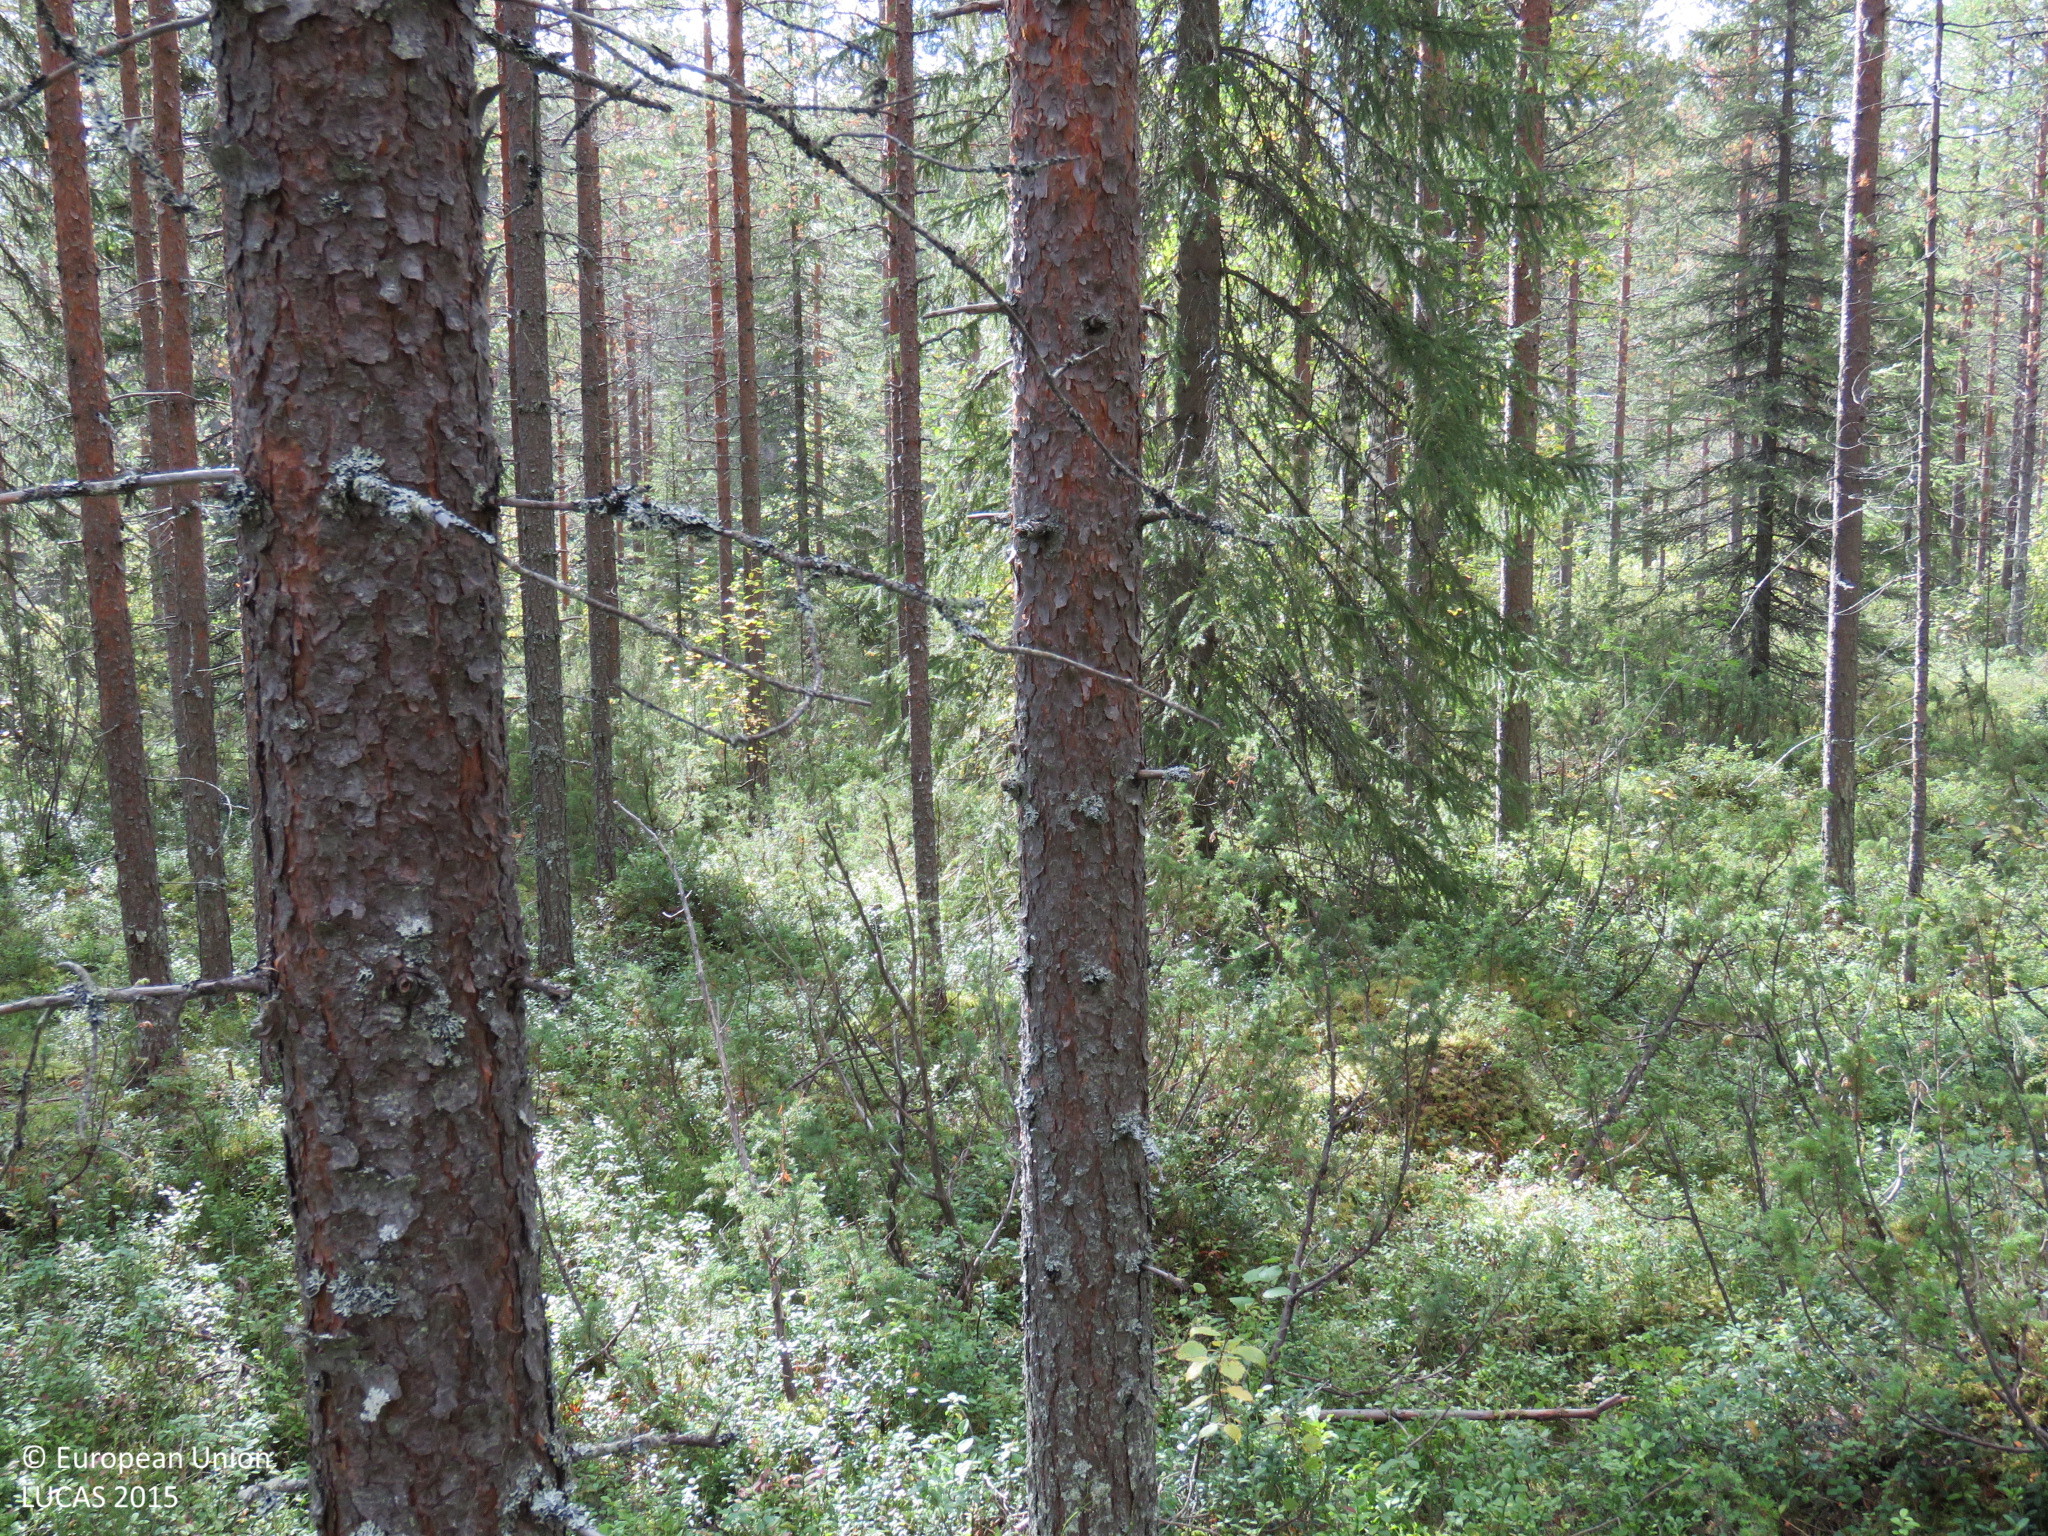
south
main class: Woodland
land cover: Other coniferous woodland
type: boreal forest
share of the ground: > 75 %
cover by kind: coniferous forest trees 60 %, shrubs 20 %, broadleaved forest trees 15 %, lichens and mosses 5 %
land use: Forestry
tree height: > 5 m
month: September
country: FI
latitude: 65.4655
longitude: 27.6376
